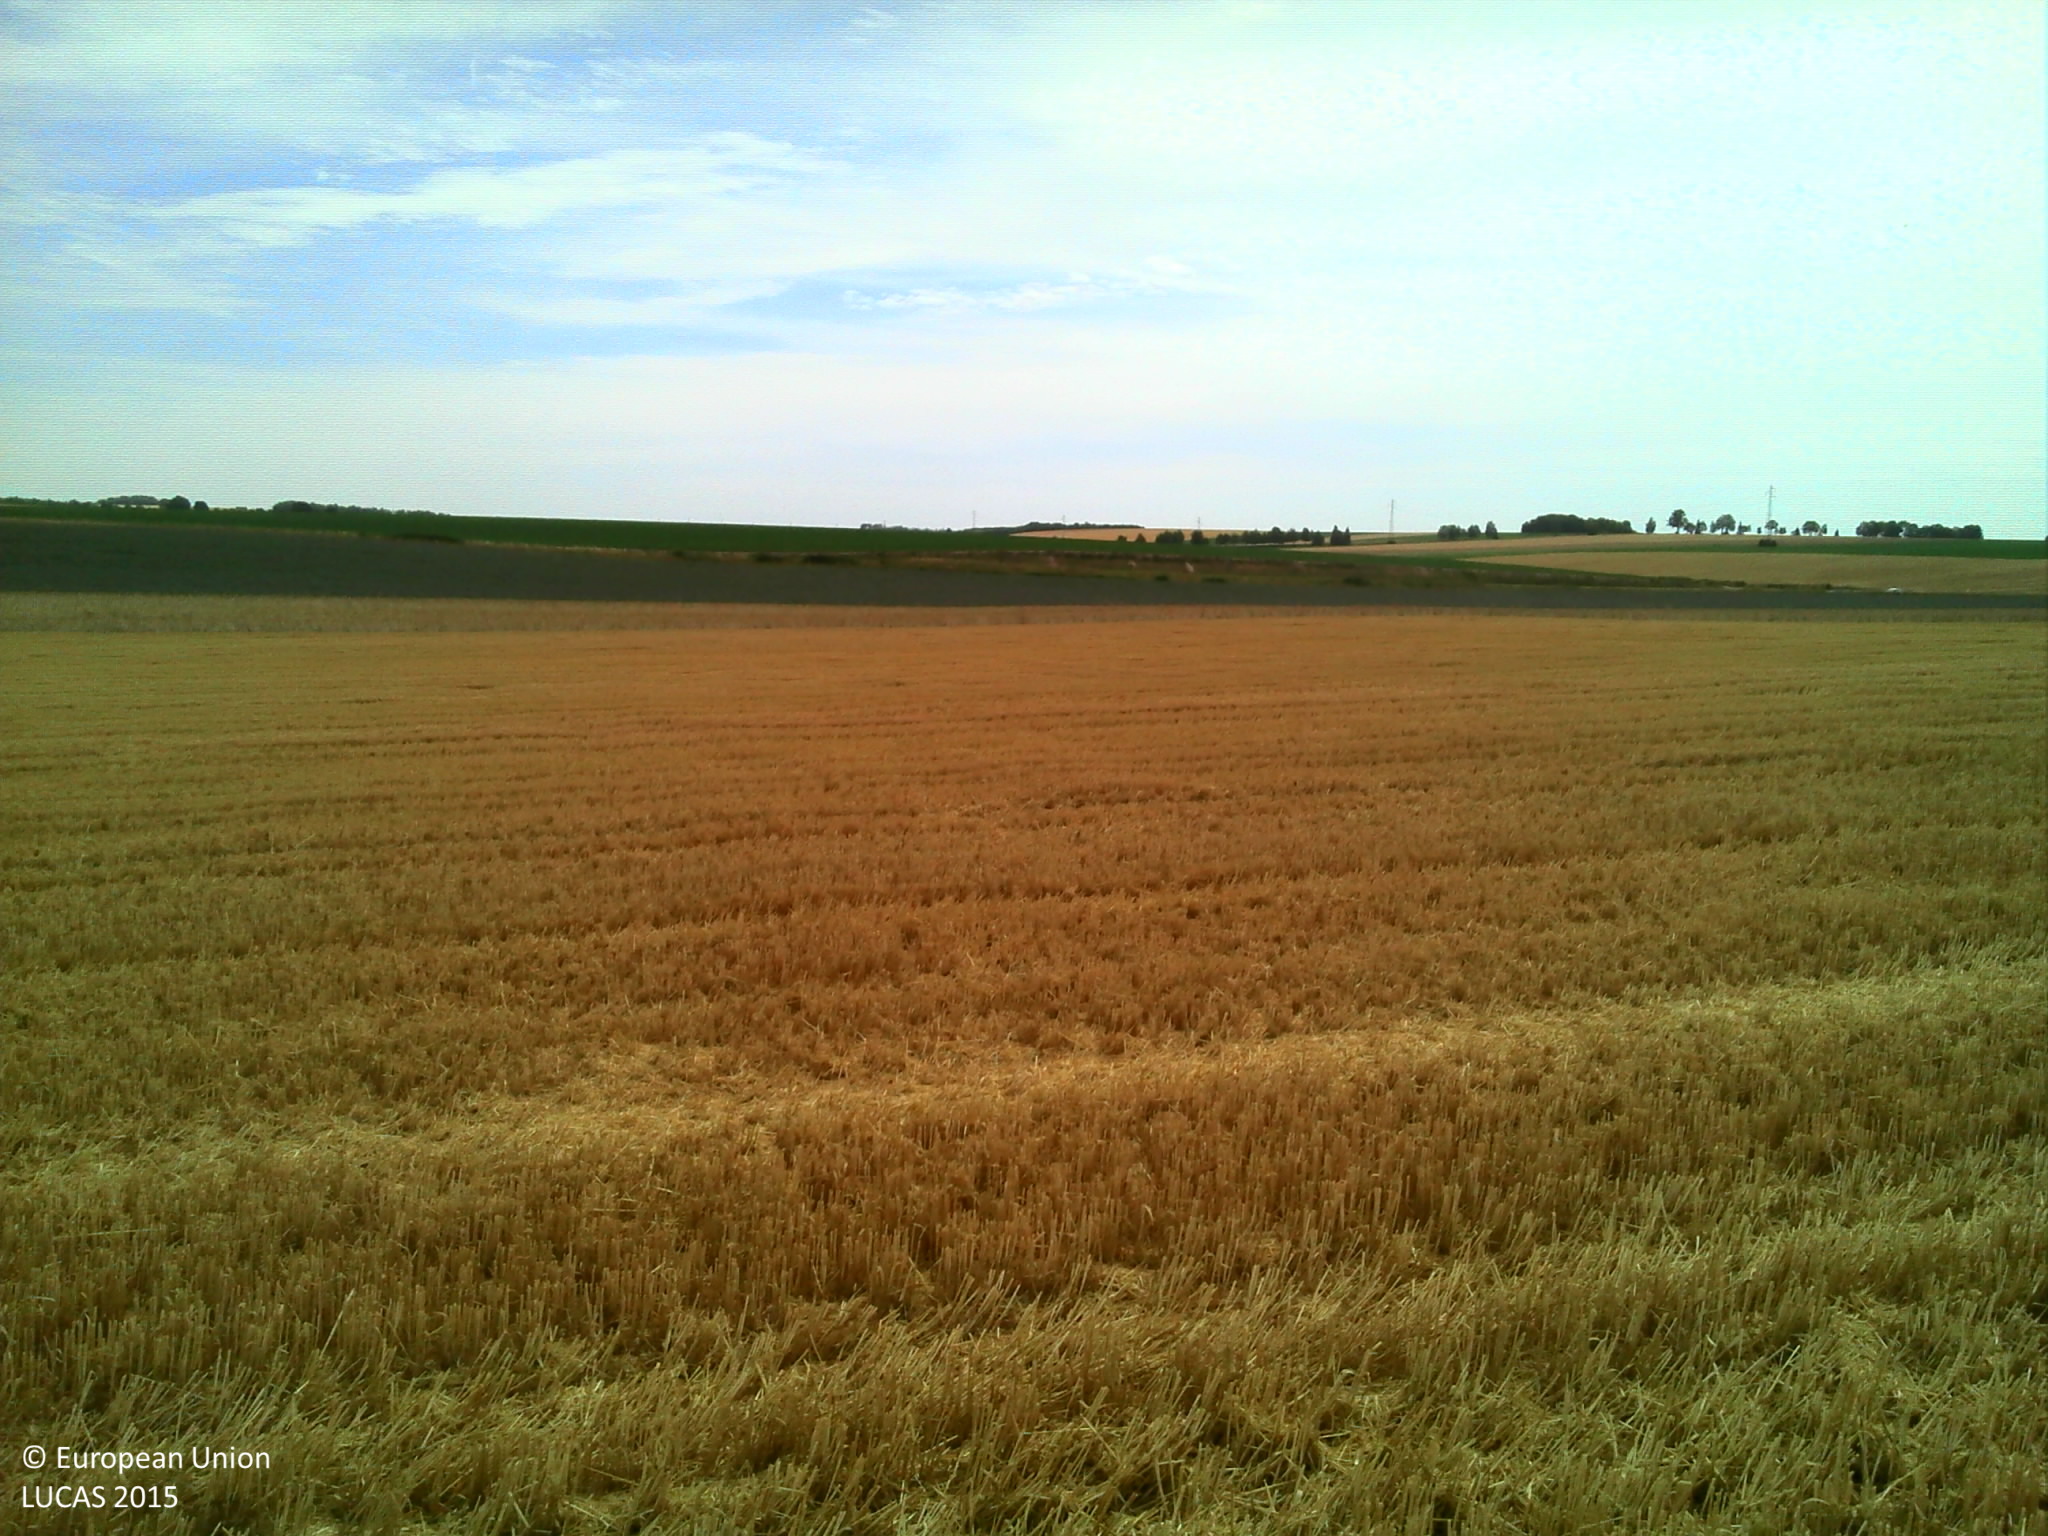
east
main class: Cropland
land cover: Barley
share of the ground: > 75 %
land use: Agriculture (excluding fallow land and kitchen gardens)
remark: Harvested field
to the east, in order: Barley; Rape and turnip rape; Lucerne
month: July
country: FR
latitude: 49.2604
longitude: 4.5414
